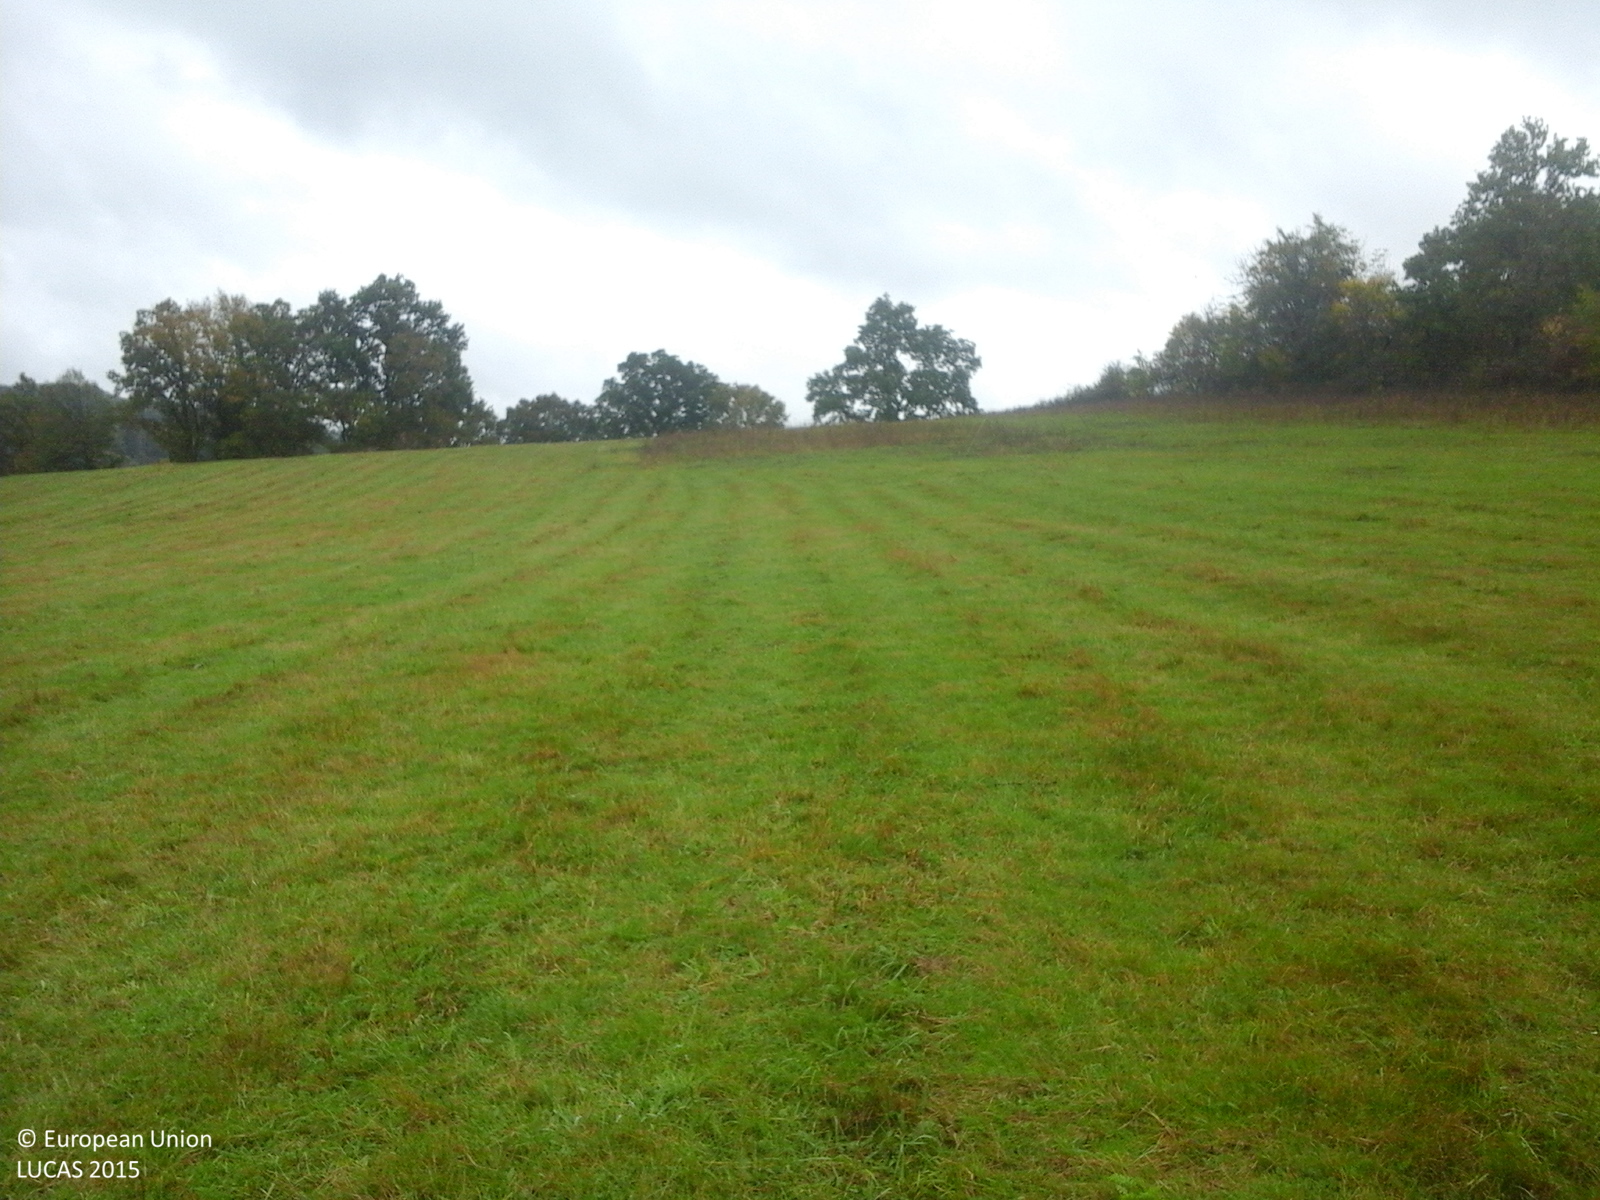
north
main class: Grassland
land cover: Grassland without tree/shrub cover
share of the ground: > 75 %
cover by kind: herbaceous plants 100 %
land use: Agriculture (excluding fallow land and kitchen gardens)
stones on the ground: < 10 %
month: October
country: RO
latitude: 45.8305
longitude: 24.6445
